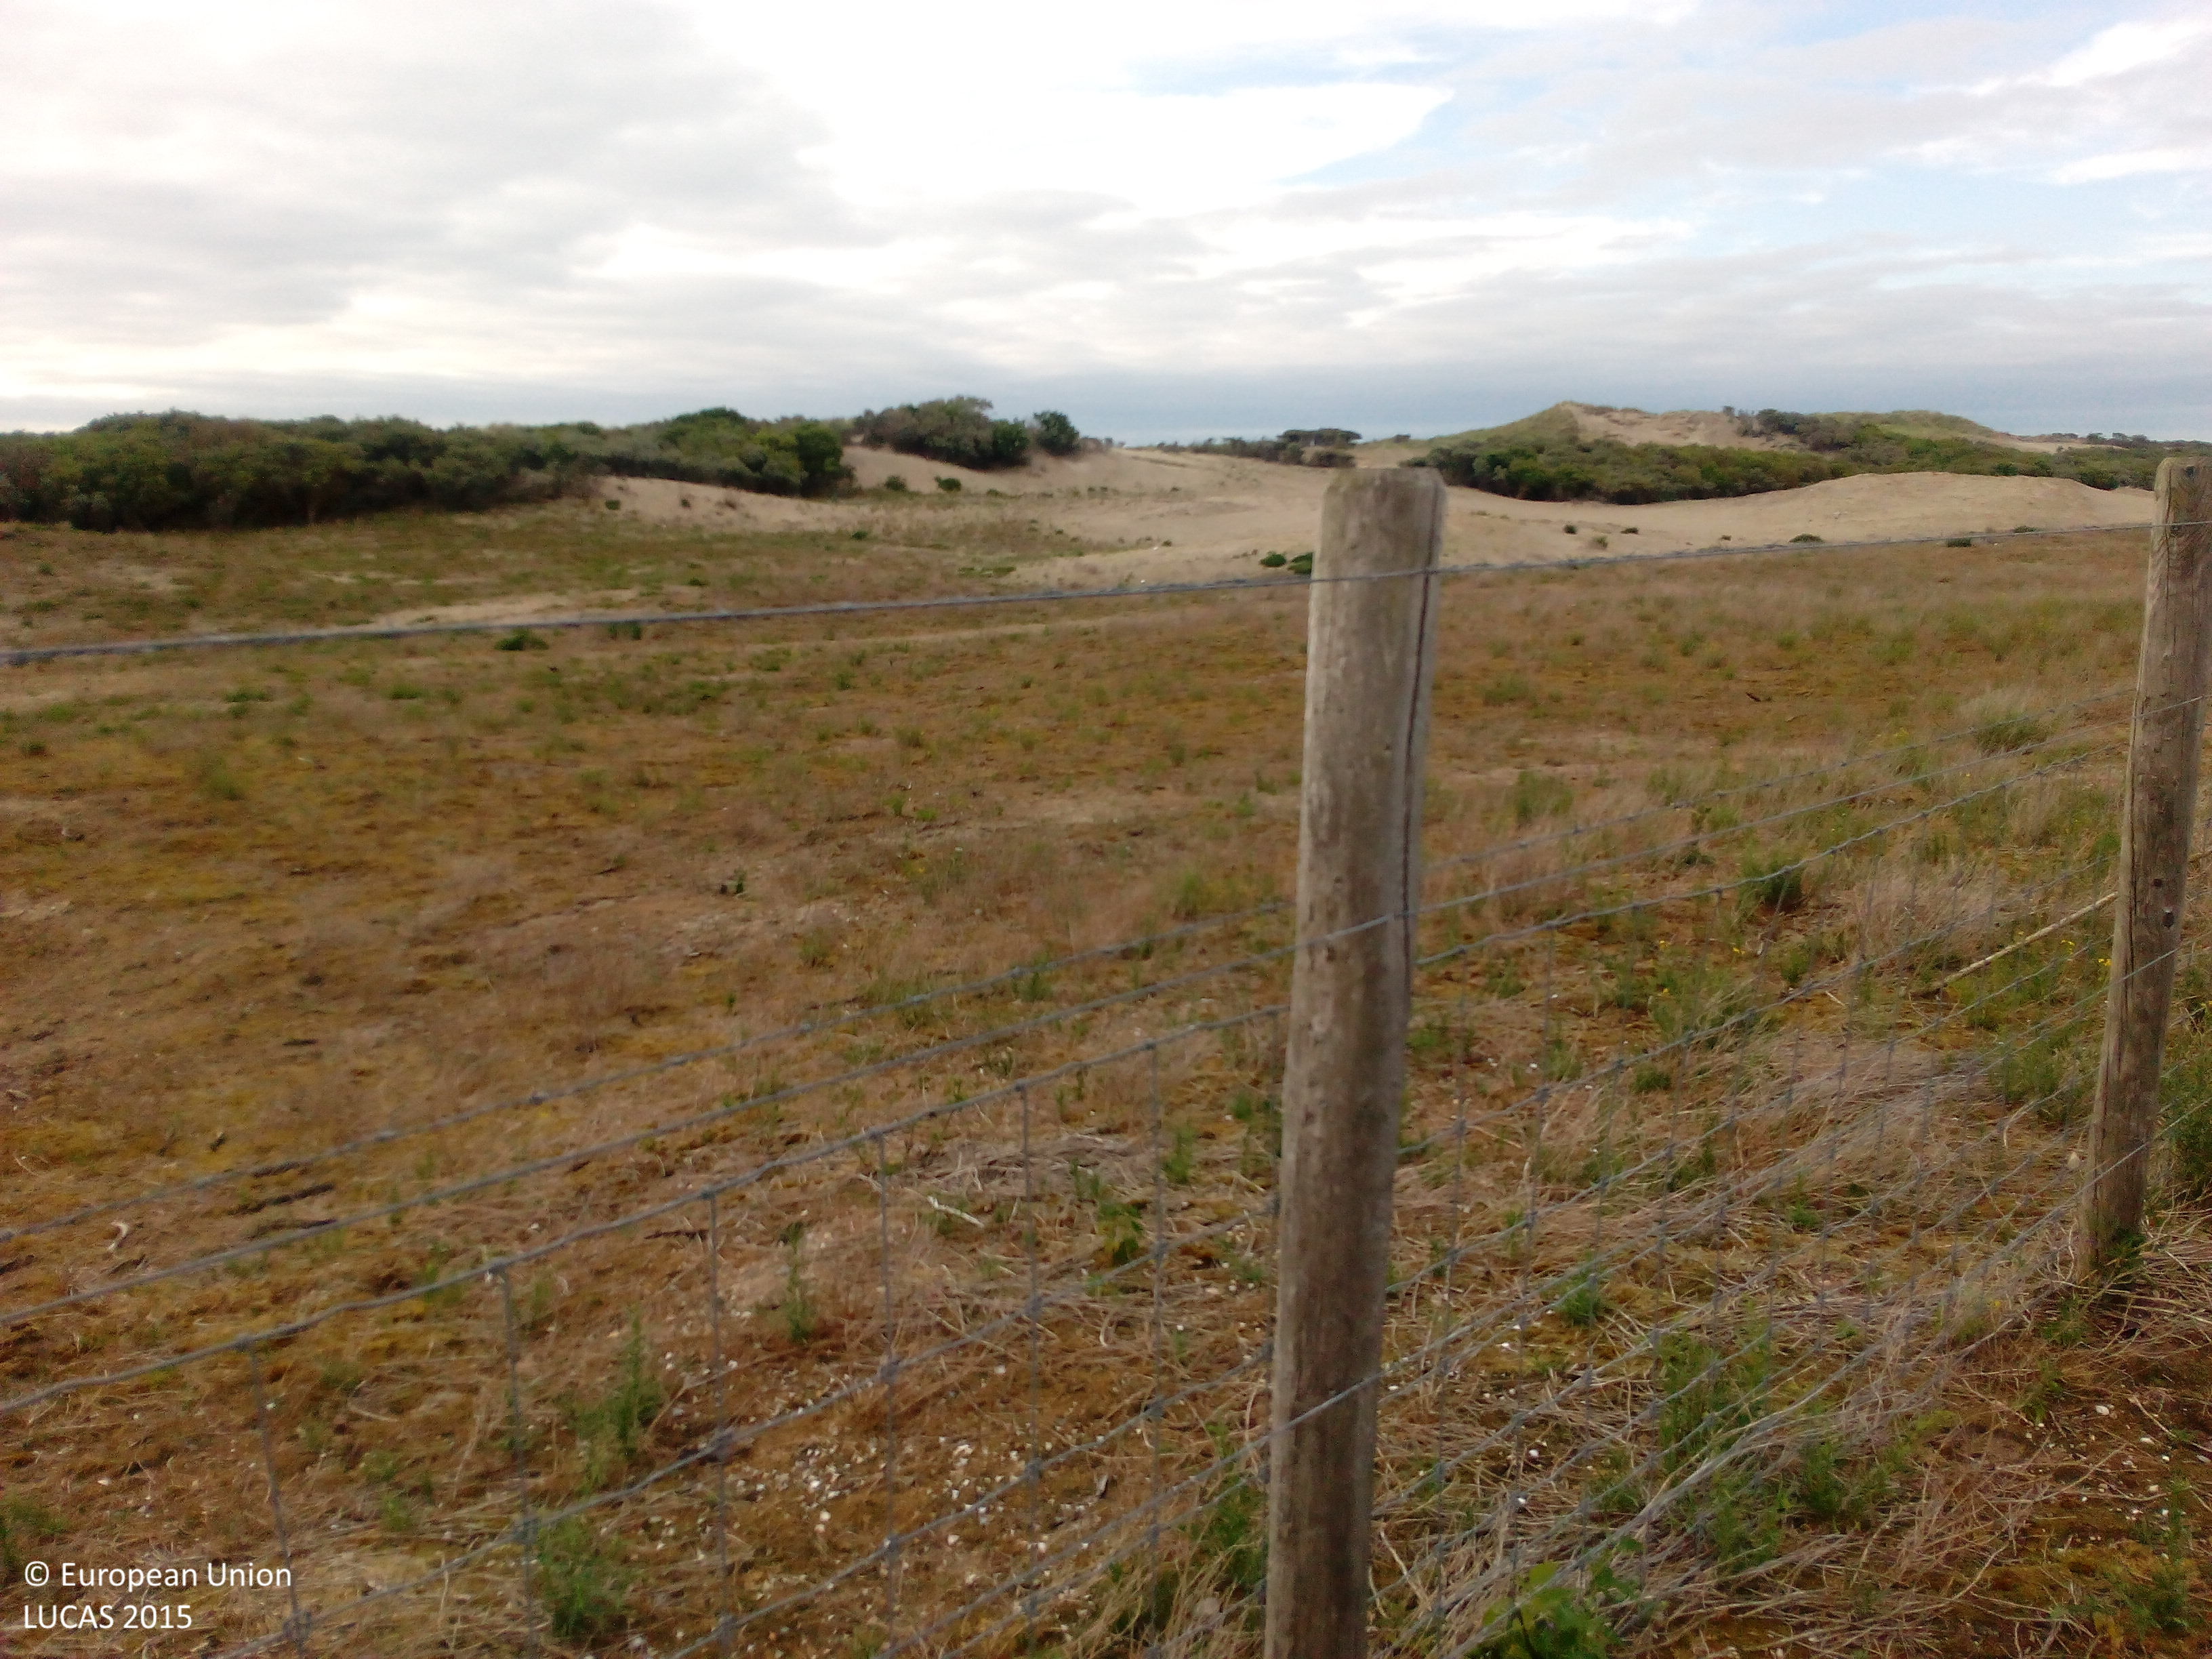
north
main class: Grassland
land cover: Grassland without tree/shrub cover
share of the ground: 50 - 75 %
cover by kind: herbaceous plants 50 %
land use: Semi-natural and natural areas not in use
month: July
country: NL
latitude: 51.9977
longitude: 4.1250
